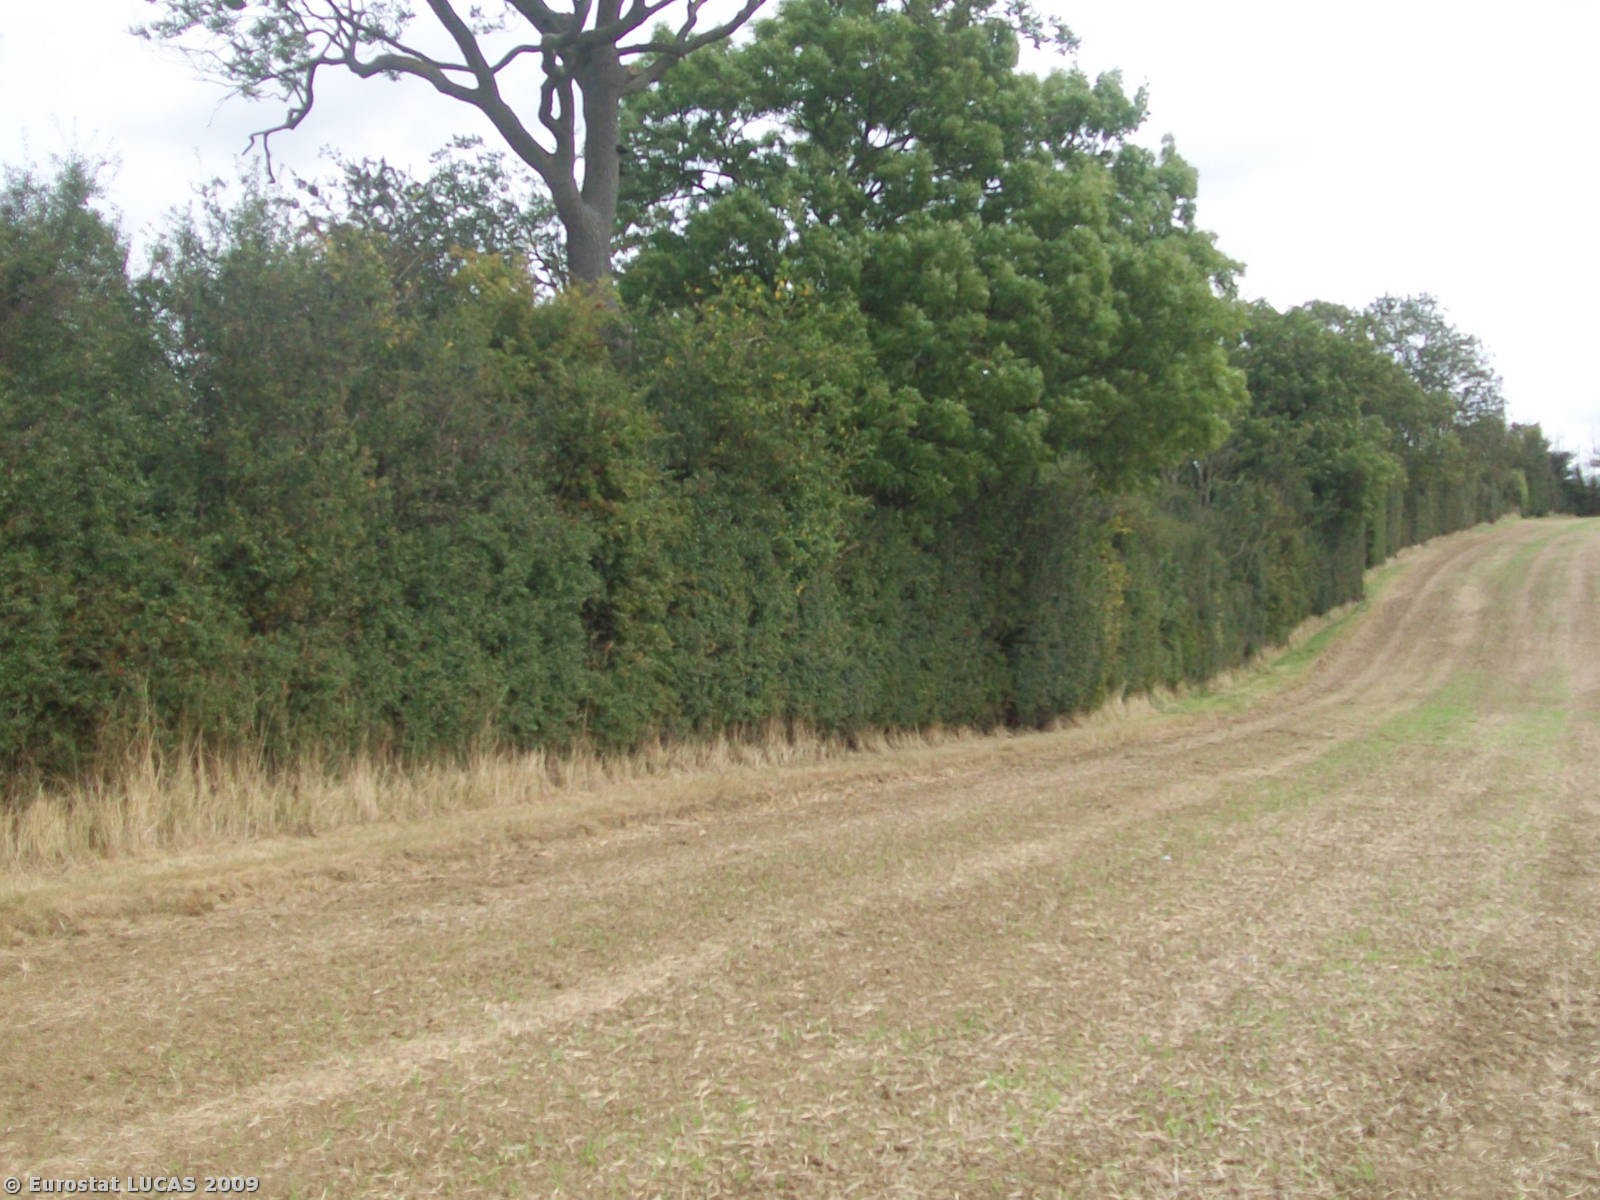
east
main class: Cropland
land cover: Common wheat
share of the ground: < 10 %
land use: Agriculture (excluding fallow land and kitchen gardens)
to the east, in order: Common wheat; Grass margins; Managed hedges; Grass margins; Bare land
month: September
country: GB
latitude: 52.4473
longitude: -1.3635
